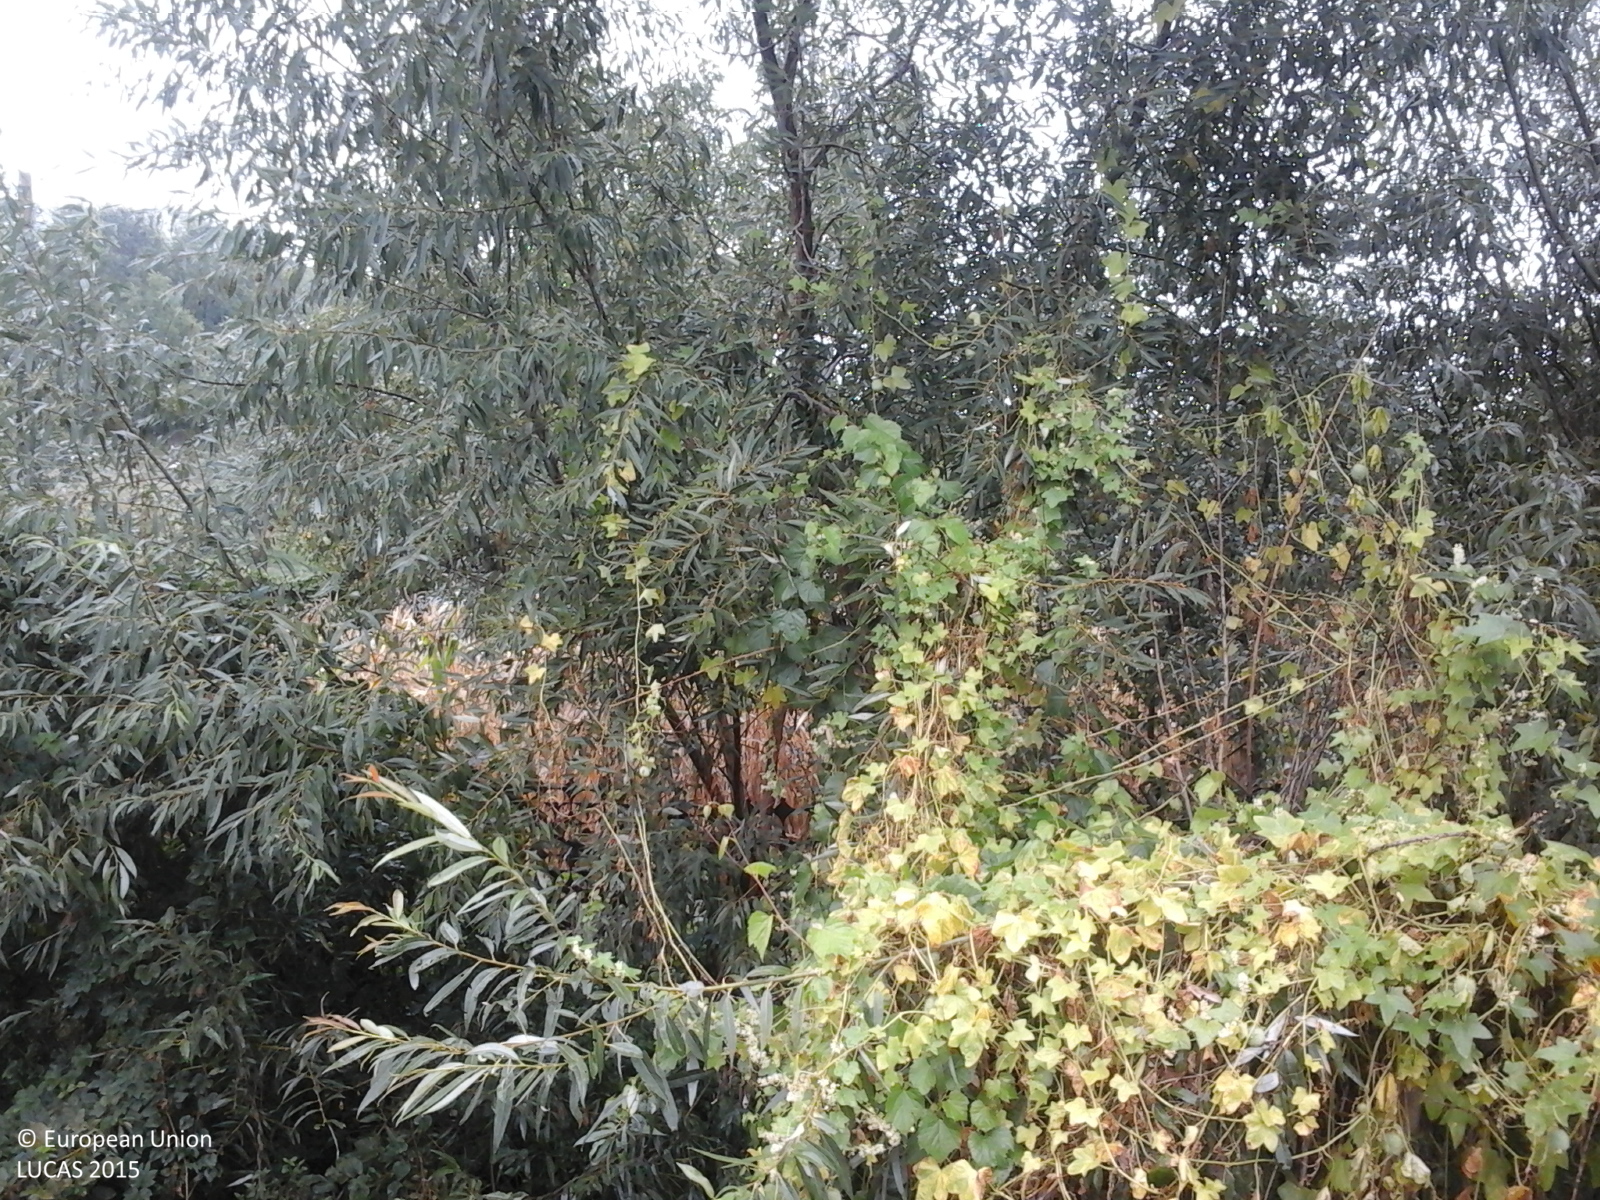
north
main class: Grassland
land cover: Grassland without tree/shrub cover
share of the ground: > 75 %
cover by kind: herbaceous plants 100 %
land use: Residential
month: September
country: RO
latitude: 47.3172
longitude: 22.4244
